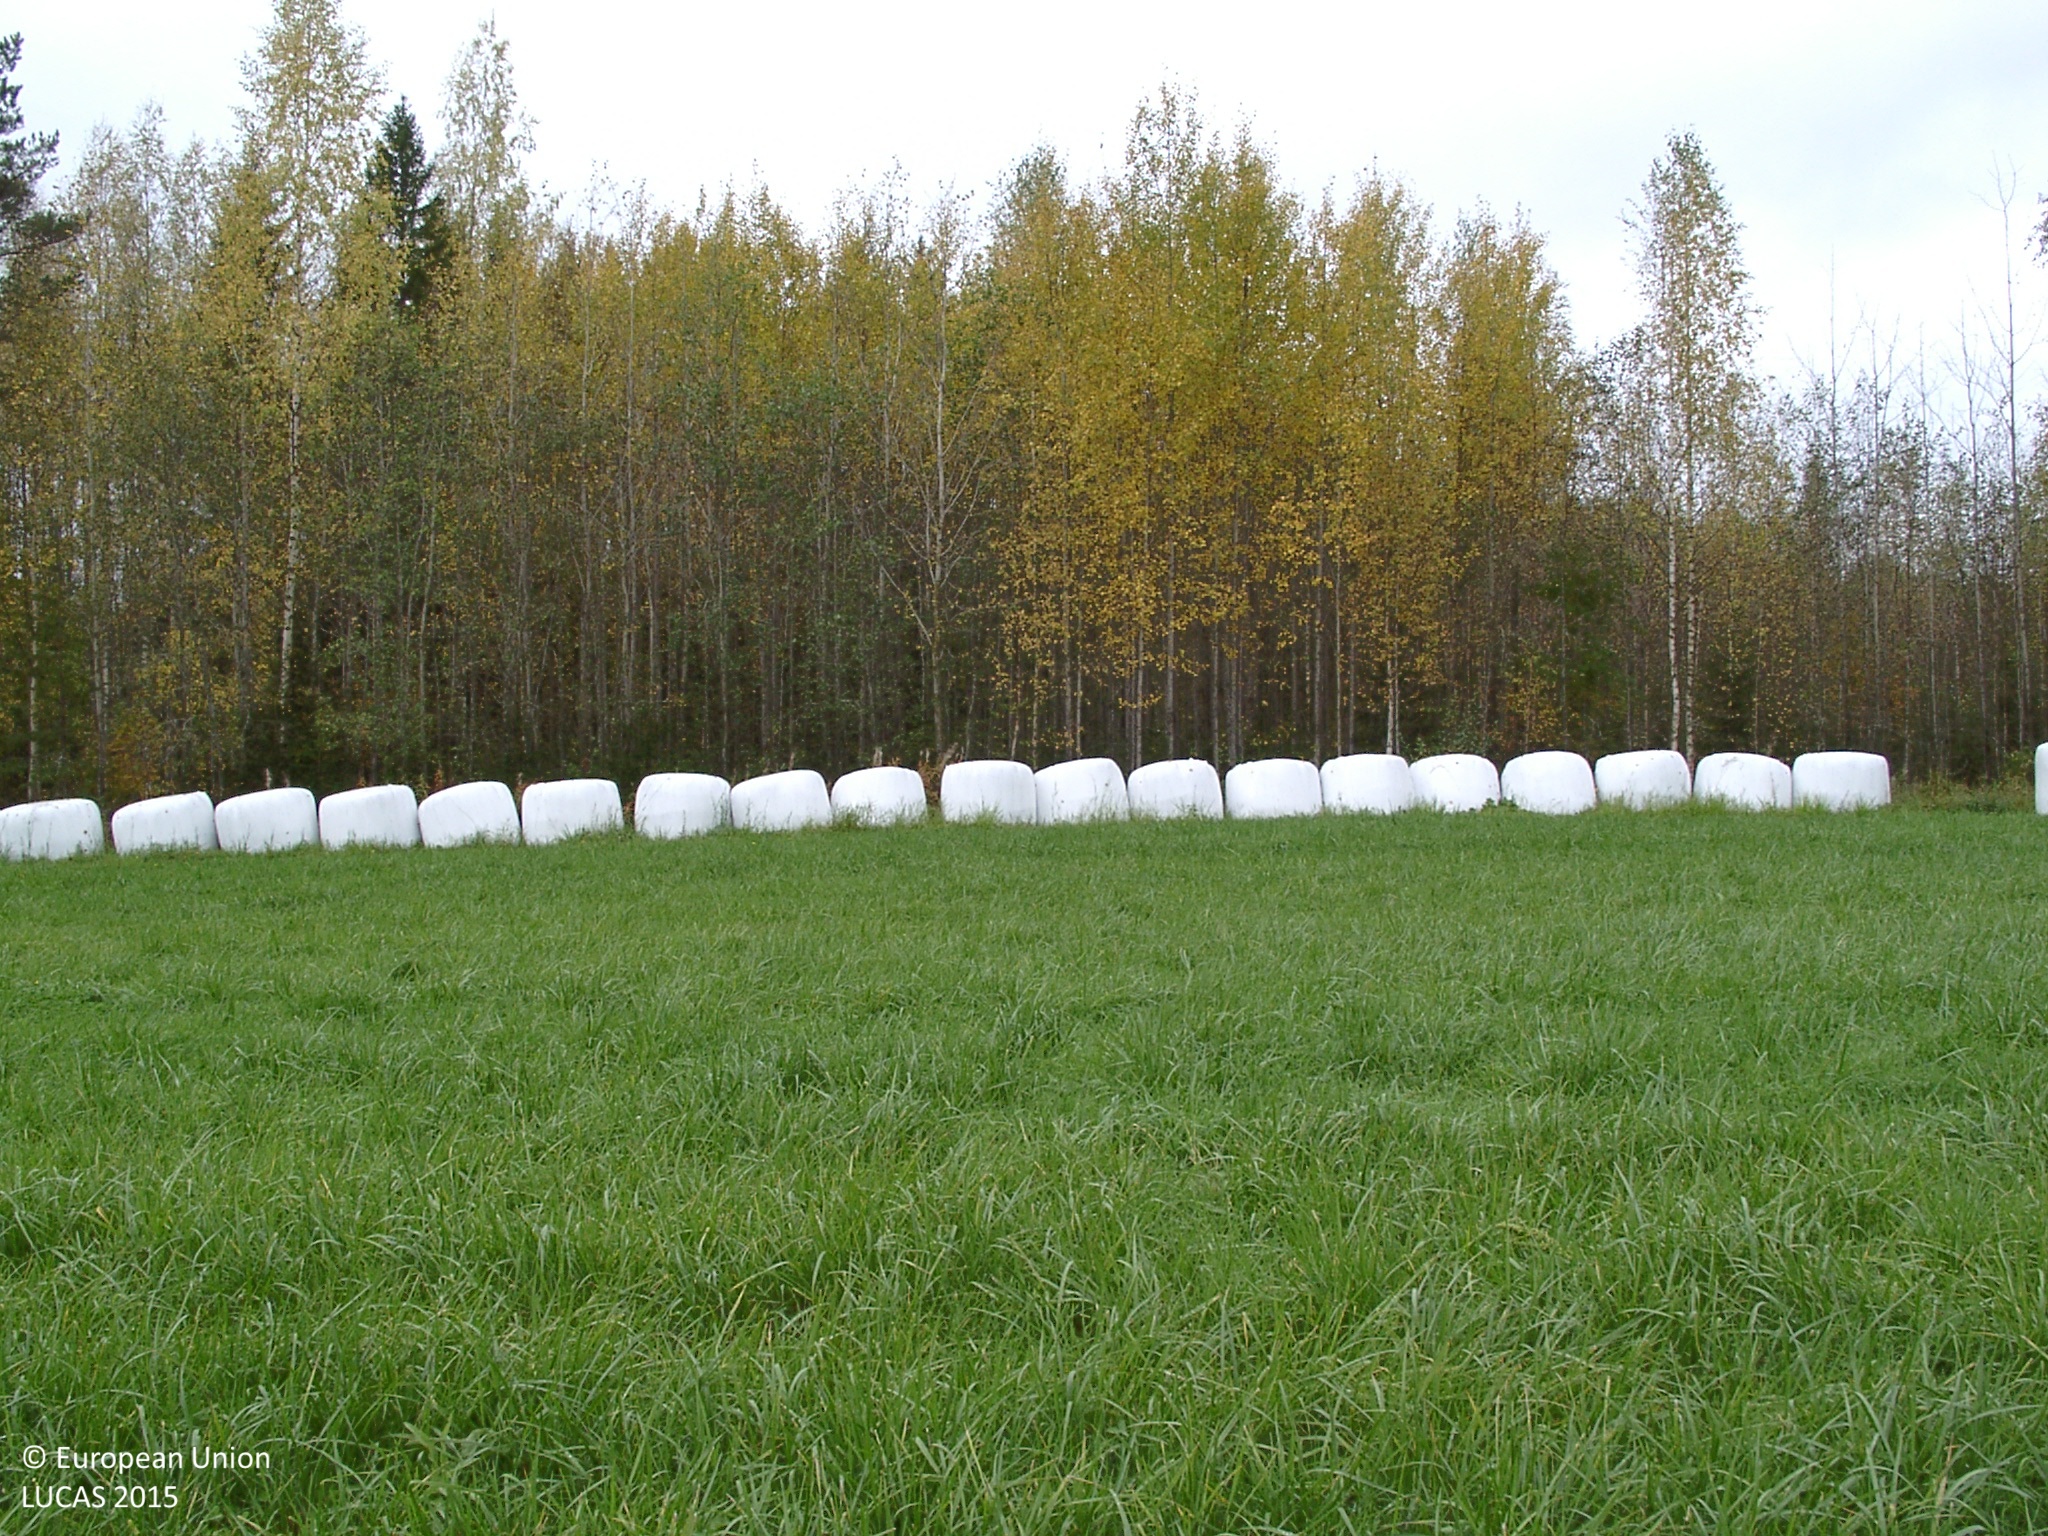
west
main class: Cropland
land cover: Other leguminous and mixtures for fodder
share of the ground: > 75 %
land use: Agriculture (excluding fallow land and kitchen gardens)
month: September
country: FI
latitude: 62.7888
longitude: 25.4163
